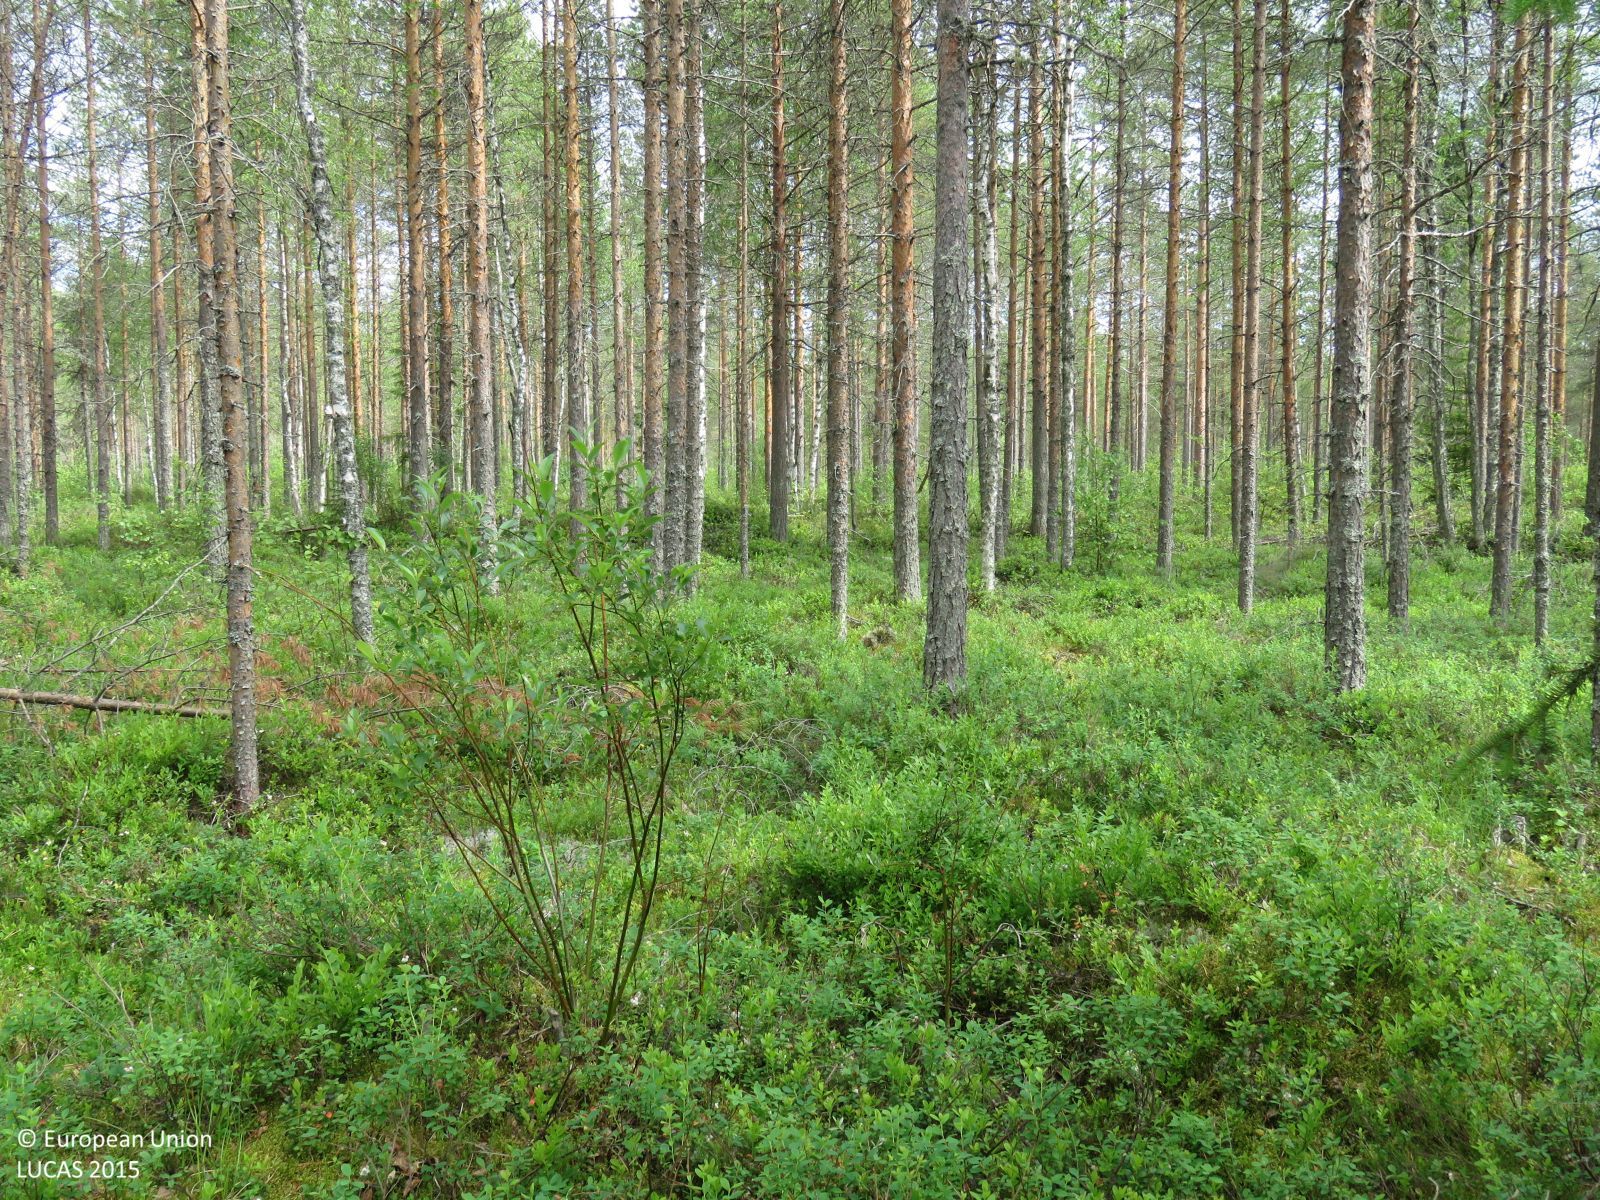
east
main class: Woodland
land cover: Pine dominated coniferous woodland
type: boreal forest
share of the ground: 50 - 75 %
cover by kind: coniferous forest trees 50 %, shrubs 25 %, broadleaved forest trees 10 %, lichens and mosses 10 %, herbaceous plants 5 %
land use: Forestry
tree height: > 5 m
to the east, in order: Pine dominated coniferous woodland; Ditches and canals; Other mixed woodland; Ditches and canals; Other coniferous woodland; Electric lines; Shrubland with sparse tree cover; Pine dominated mixed woodland; Ditches and canals; Shrubland with sparse tree cover; Tracks; Pine dominated coniferous woodland; Ditches and canals; Pine dominated mixed woodland; Pine dominated coniferous woodland; Shrubland with sparse tree cover; Pine dominated coniferous woodland; Ditches and canals; Pine dominated coniferous woodland
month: July
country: FI
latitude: 64.4469
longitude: 26.5522
